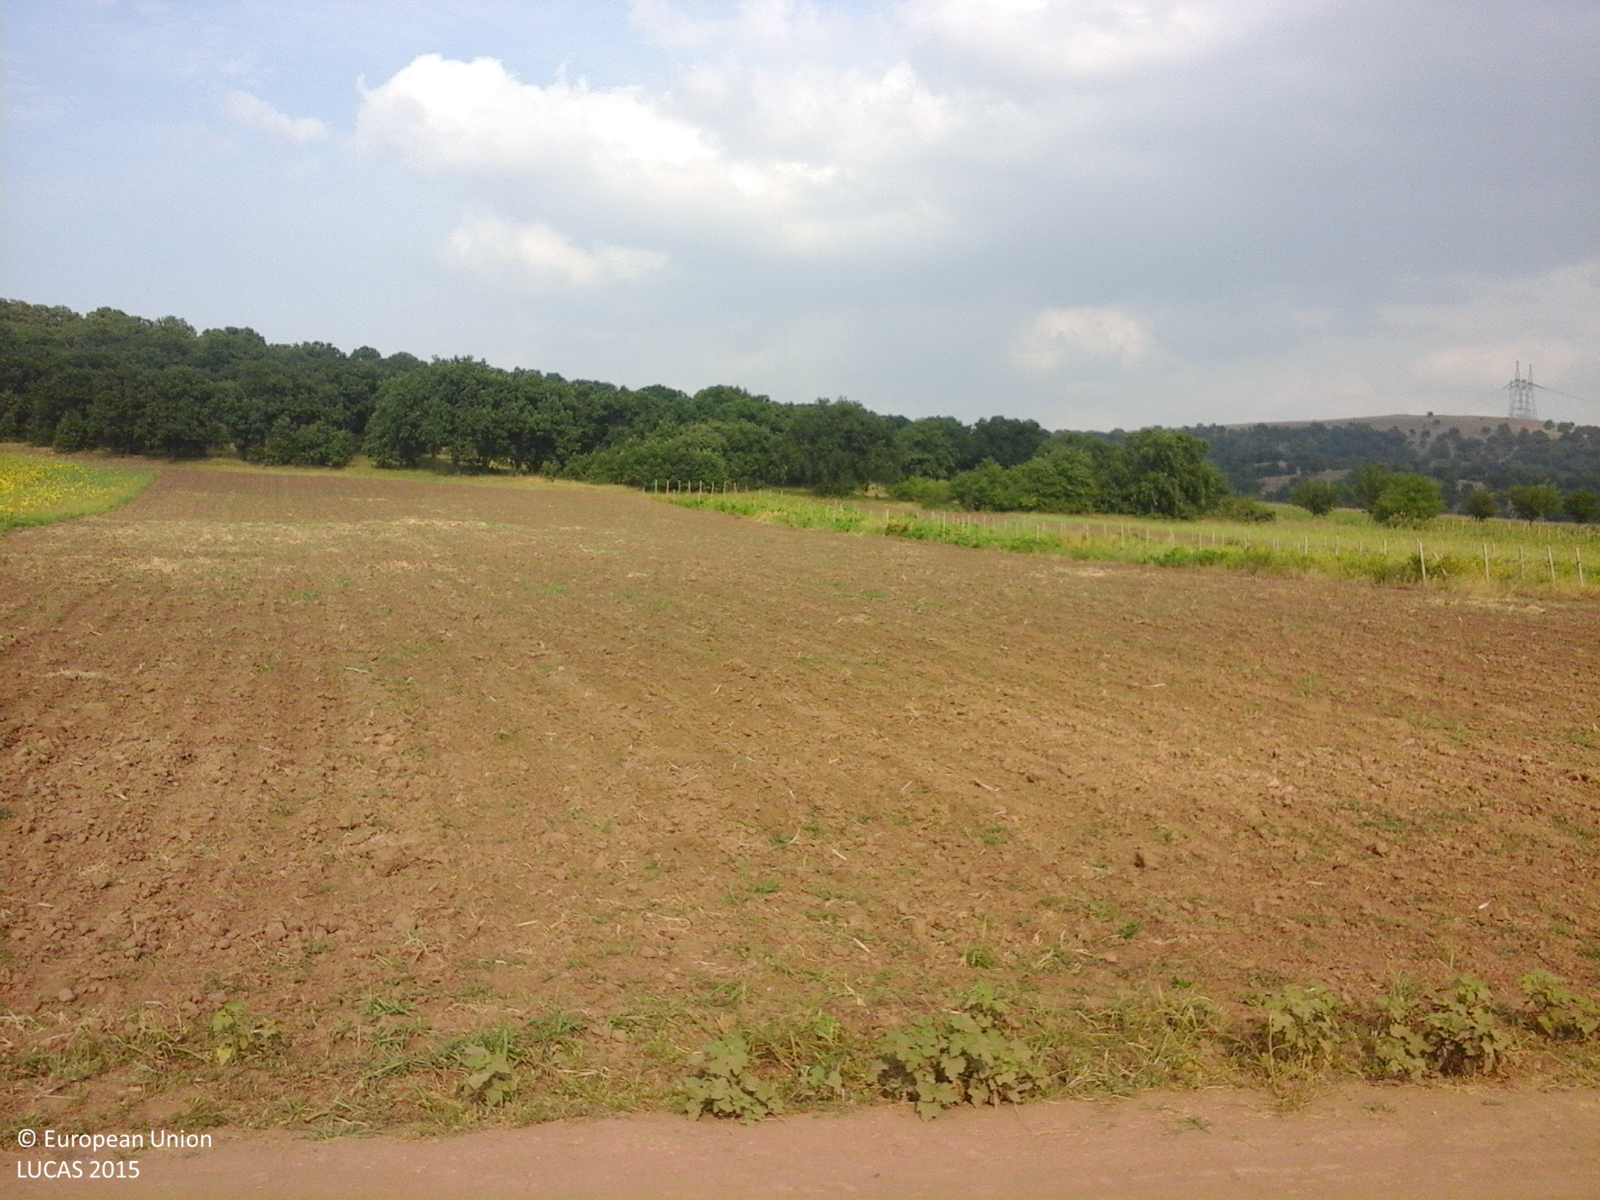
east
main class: Cropland
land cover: Sunflower
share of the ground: > 75 %
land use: Agriculture (excluding fallow land and kitchen gardens)
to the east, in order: Sunflower; Tracks; Other bare soil; Vineyards; Other bare soil
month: July
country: RO
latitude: 45.0990
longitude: 28.4398
